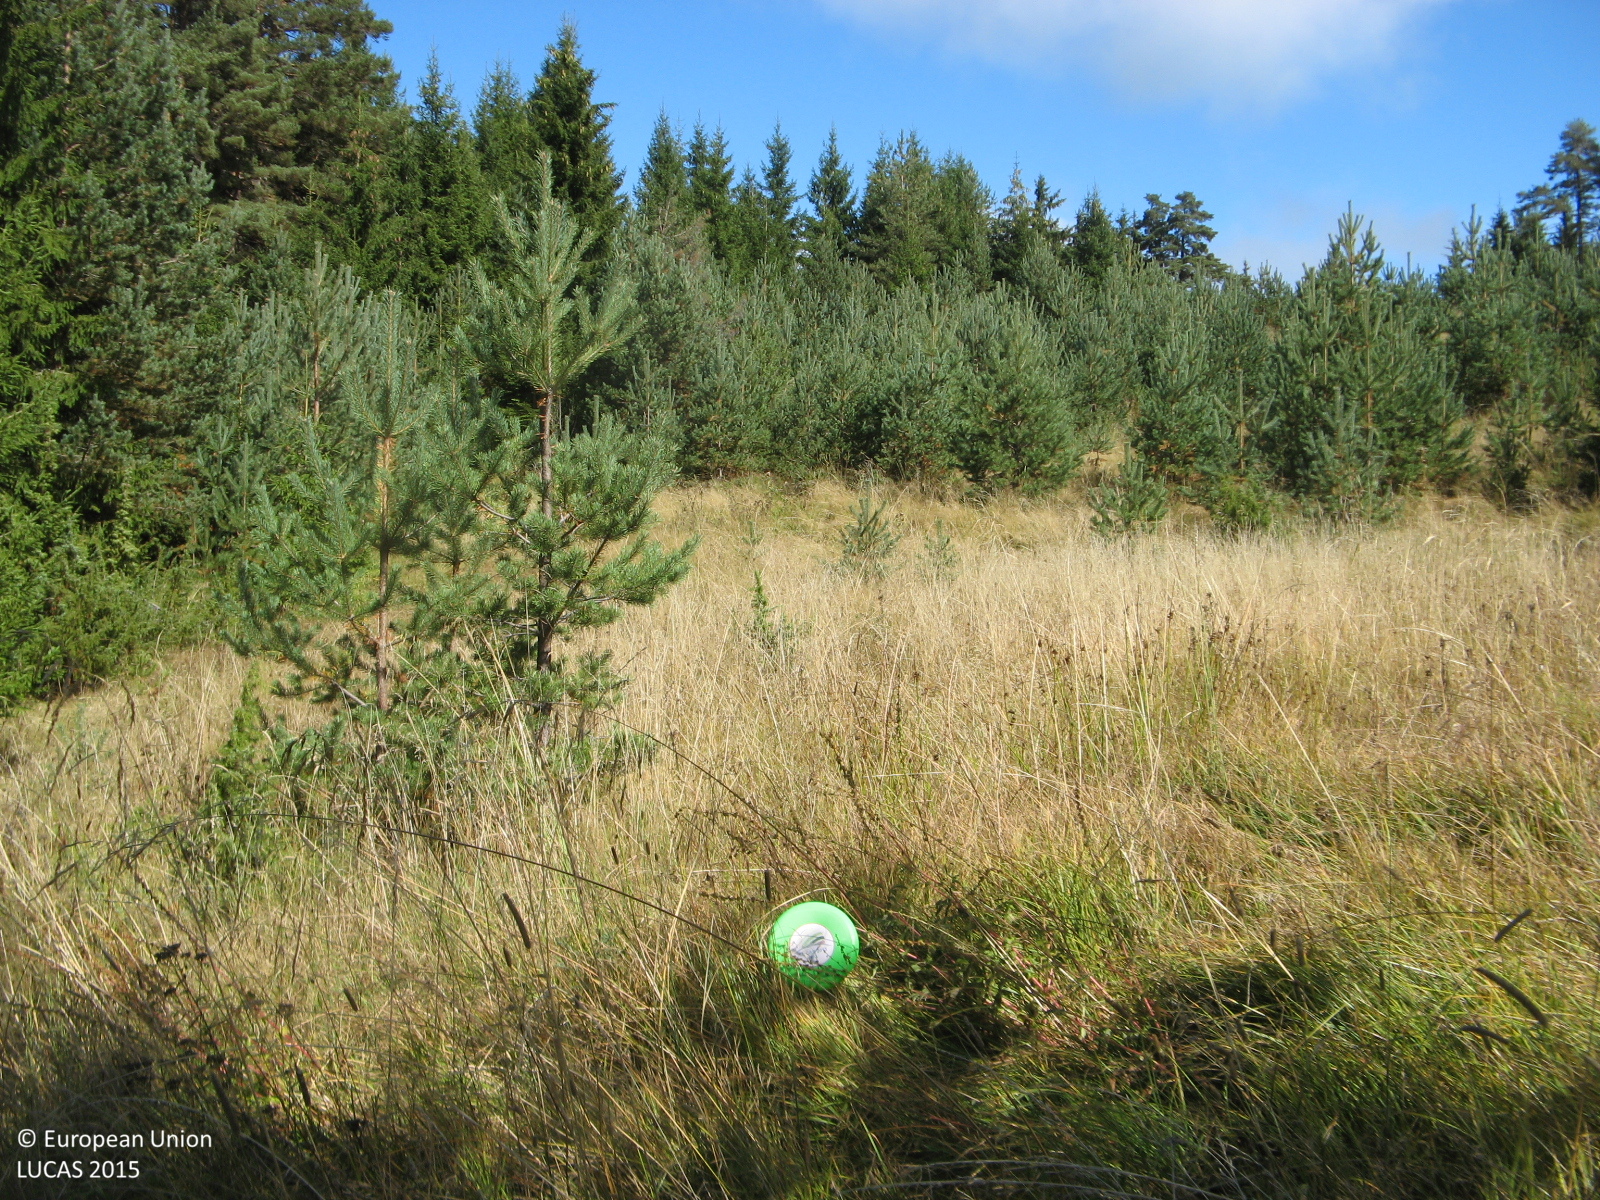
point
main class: Grassland
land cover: Grassland with sparse tree/shrub cover
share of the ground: > 75 %
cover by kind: herbaceous plants 90 %, coniferous forest trees 5 %, shrubs 5 %
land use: Fallow land
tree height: < 5 m
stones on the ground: < 10 %
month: September
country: BG
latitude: 41.5971
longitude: 24.4242
